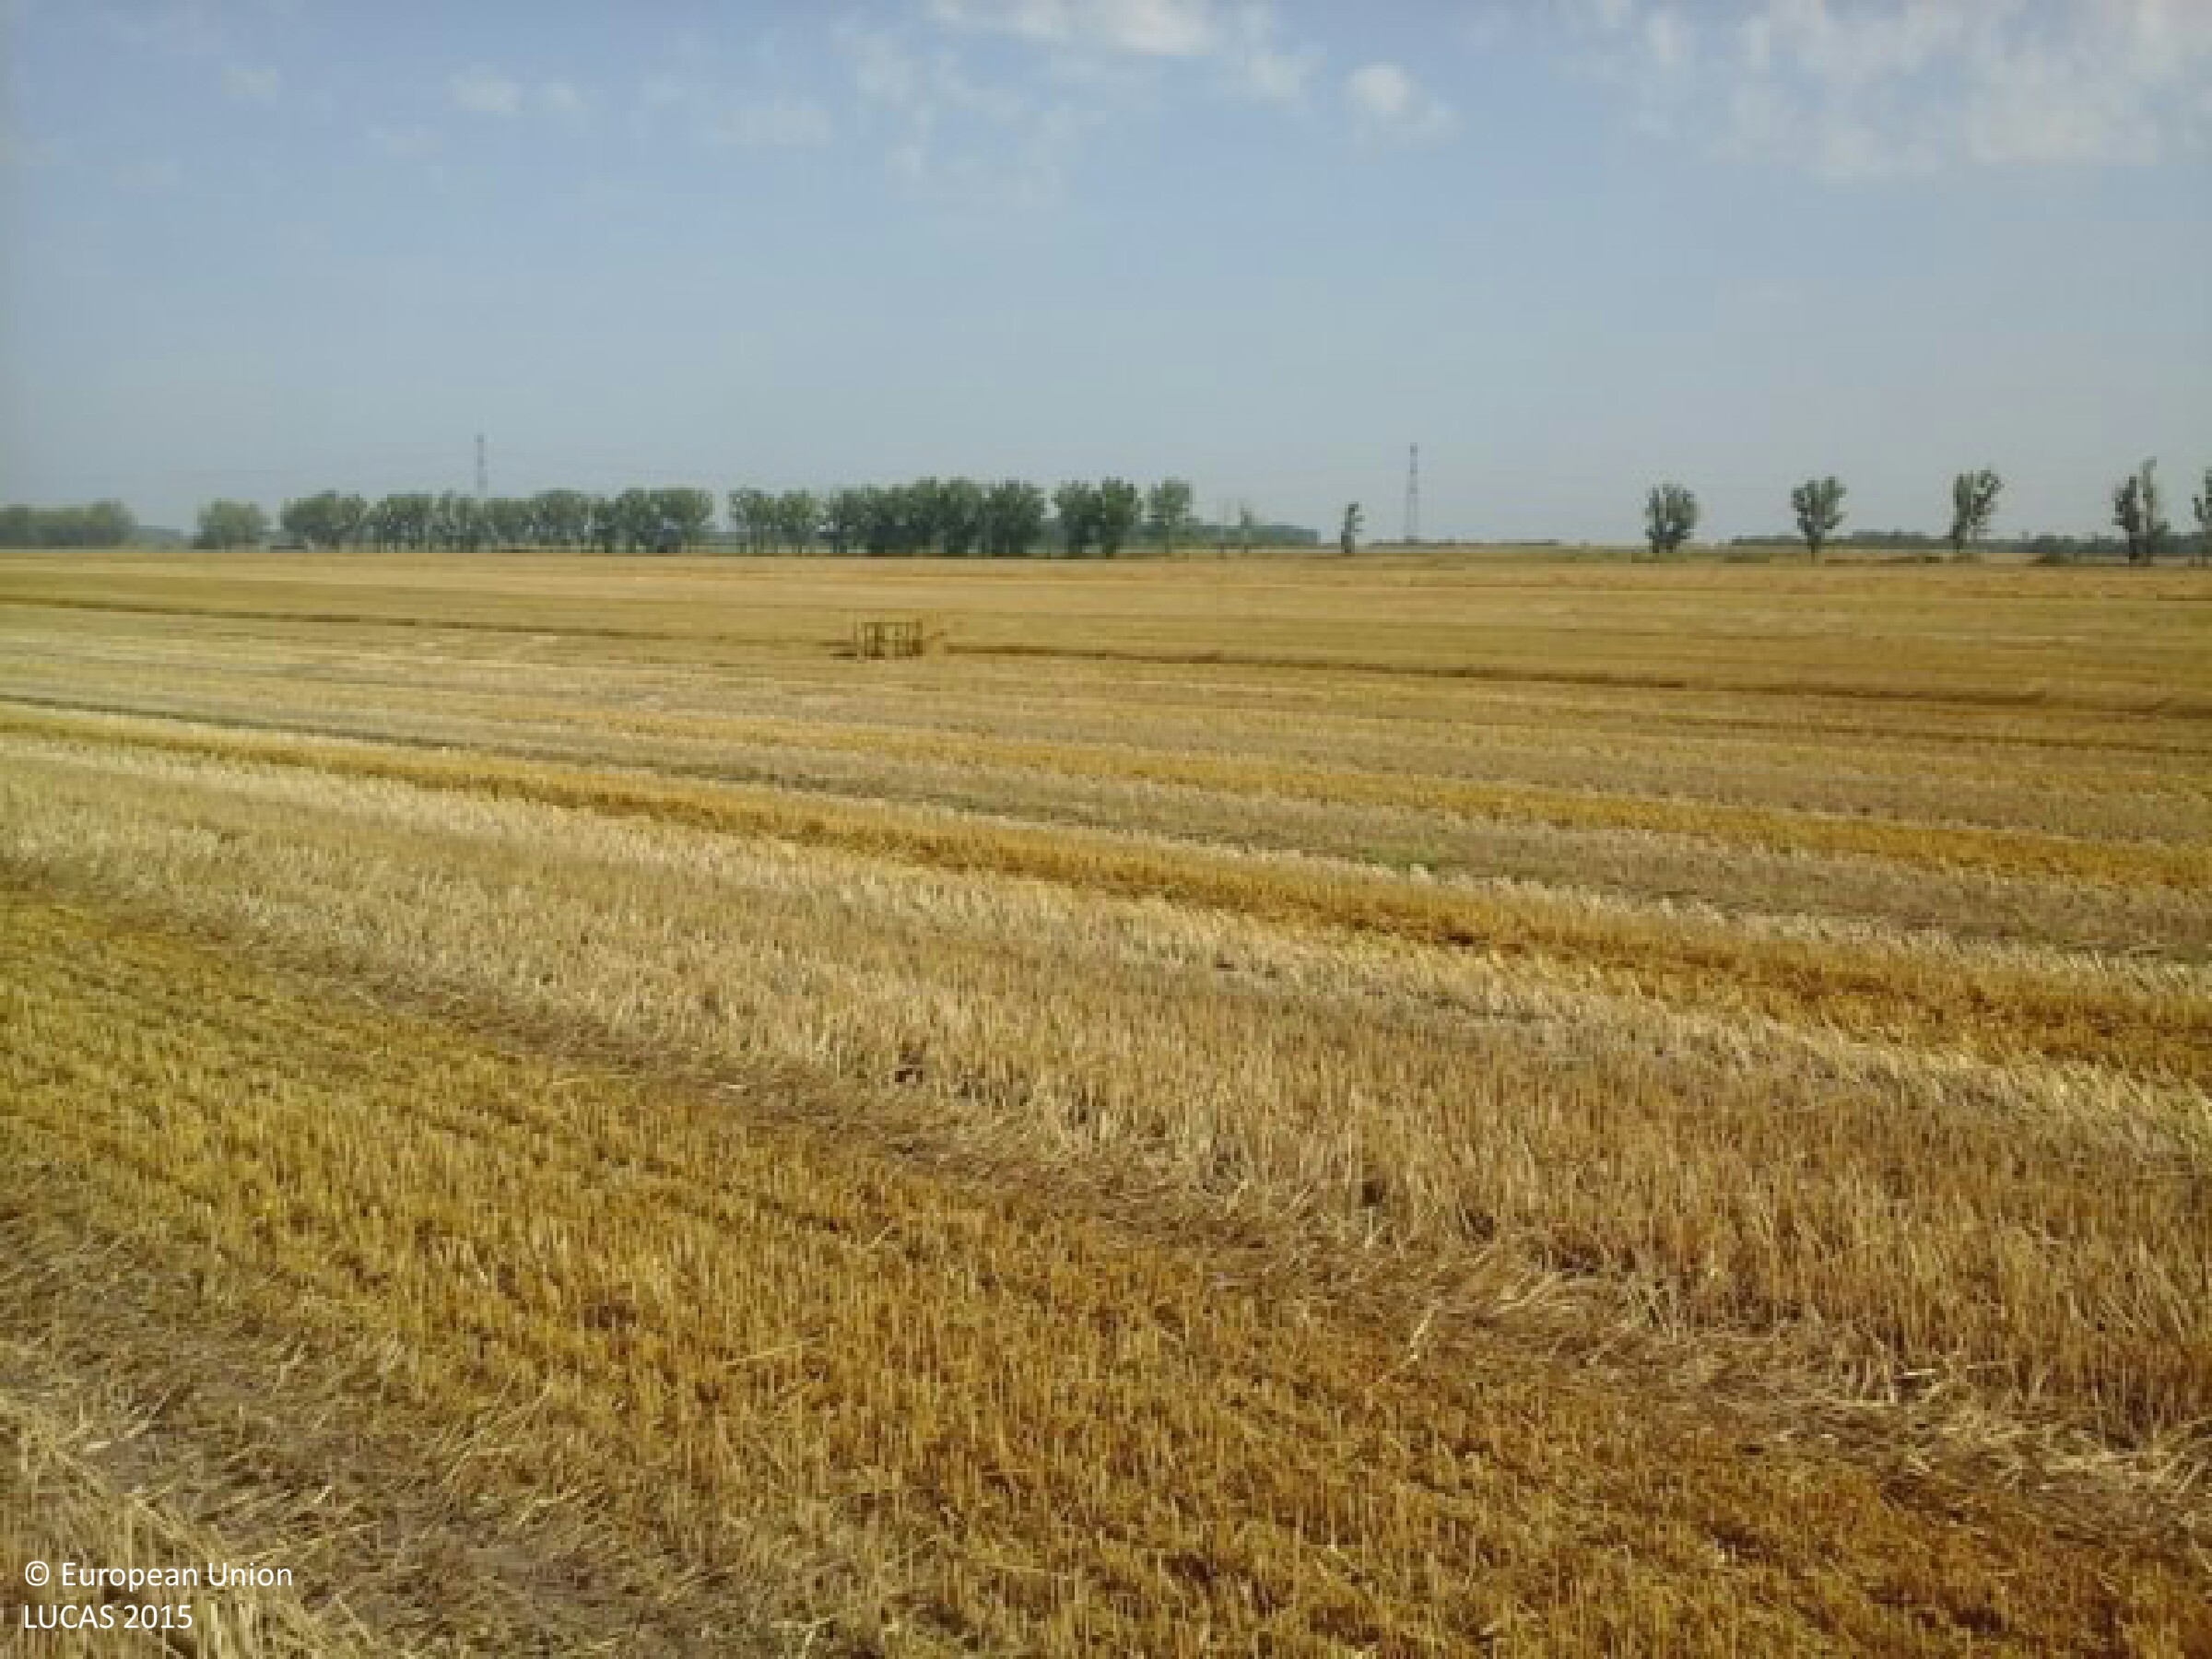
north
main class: Cropland
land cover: Common wheat
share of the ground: 25 - 50 %
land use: Agriculture (excluding fallow land and kitchen gardens)
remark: Harvested field
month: August
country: HU
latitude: 47.2359
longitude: 19.0387
